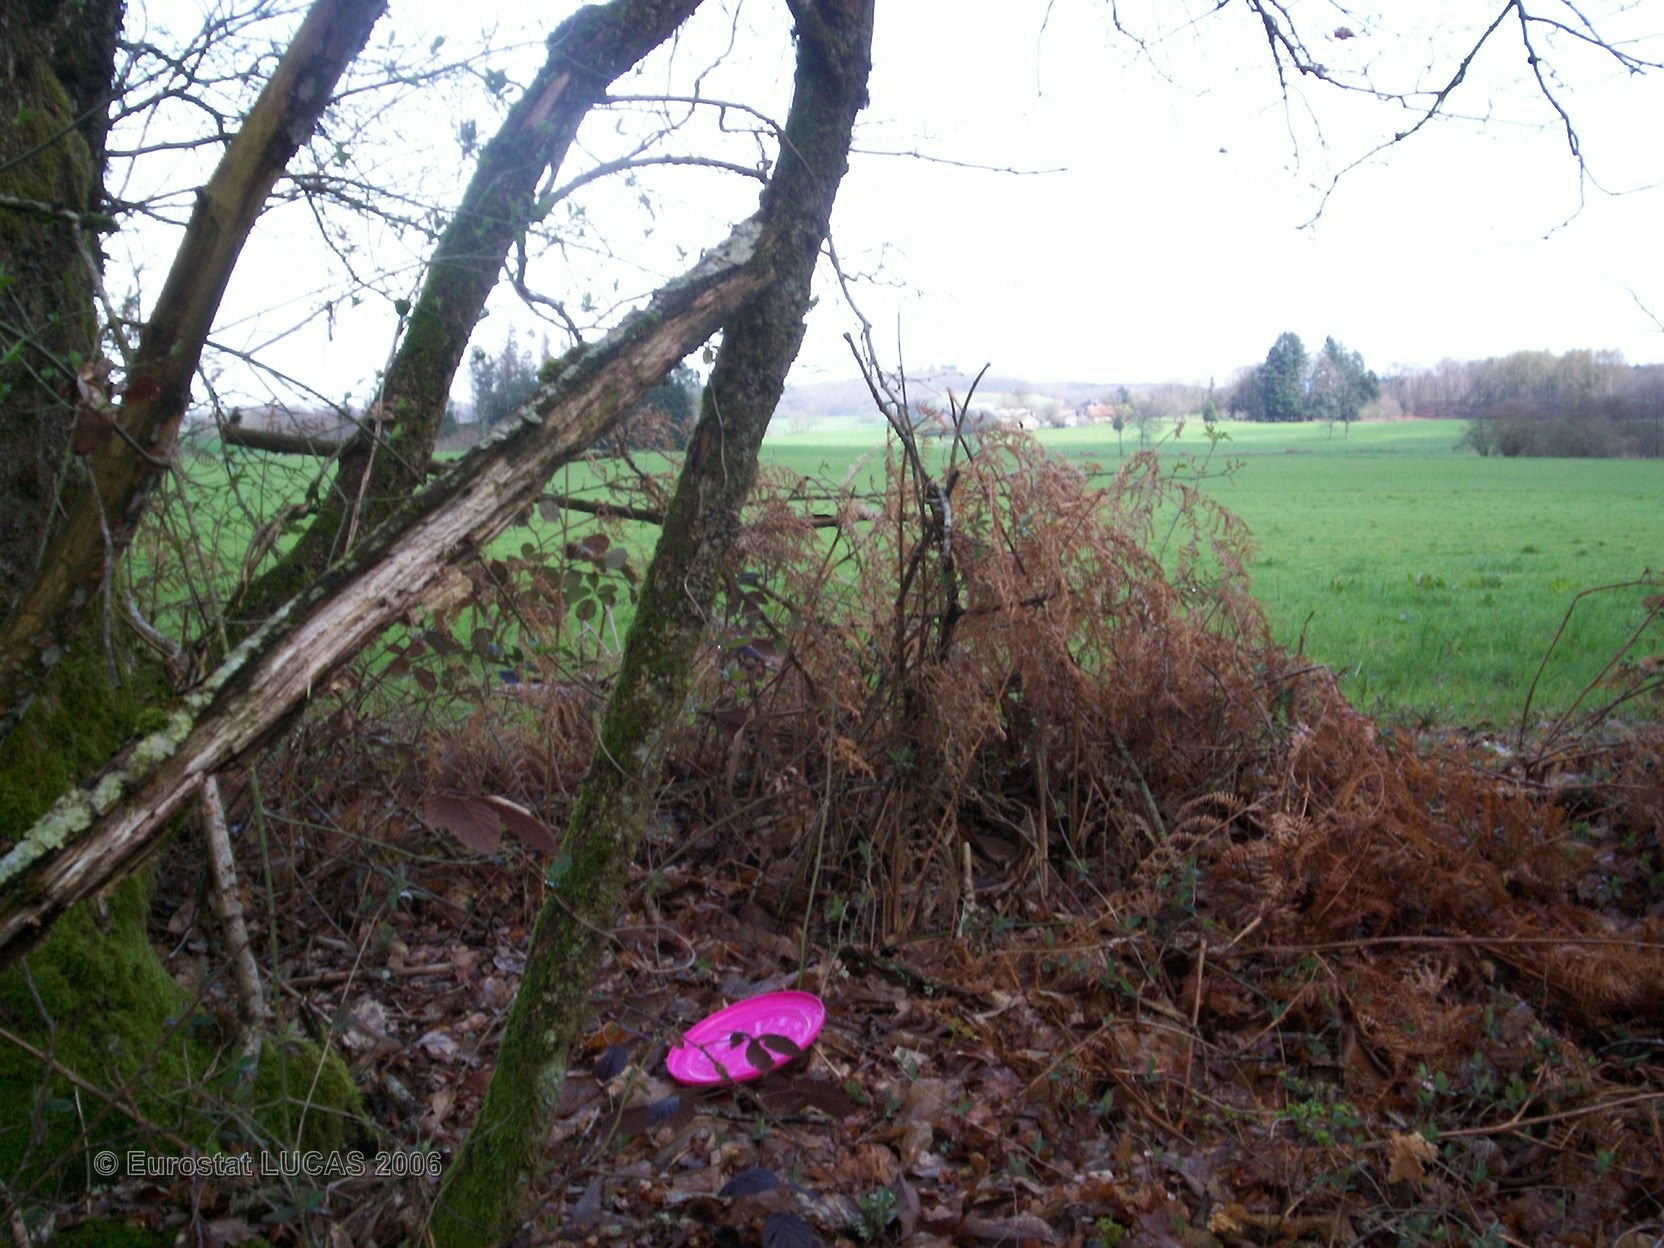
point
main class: Woodland
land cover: Broadleaved forest
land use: Forestry
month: April
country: FR
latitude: 45.5499
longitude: 1.6041
